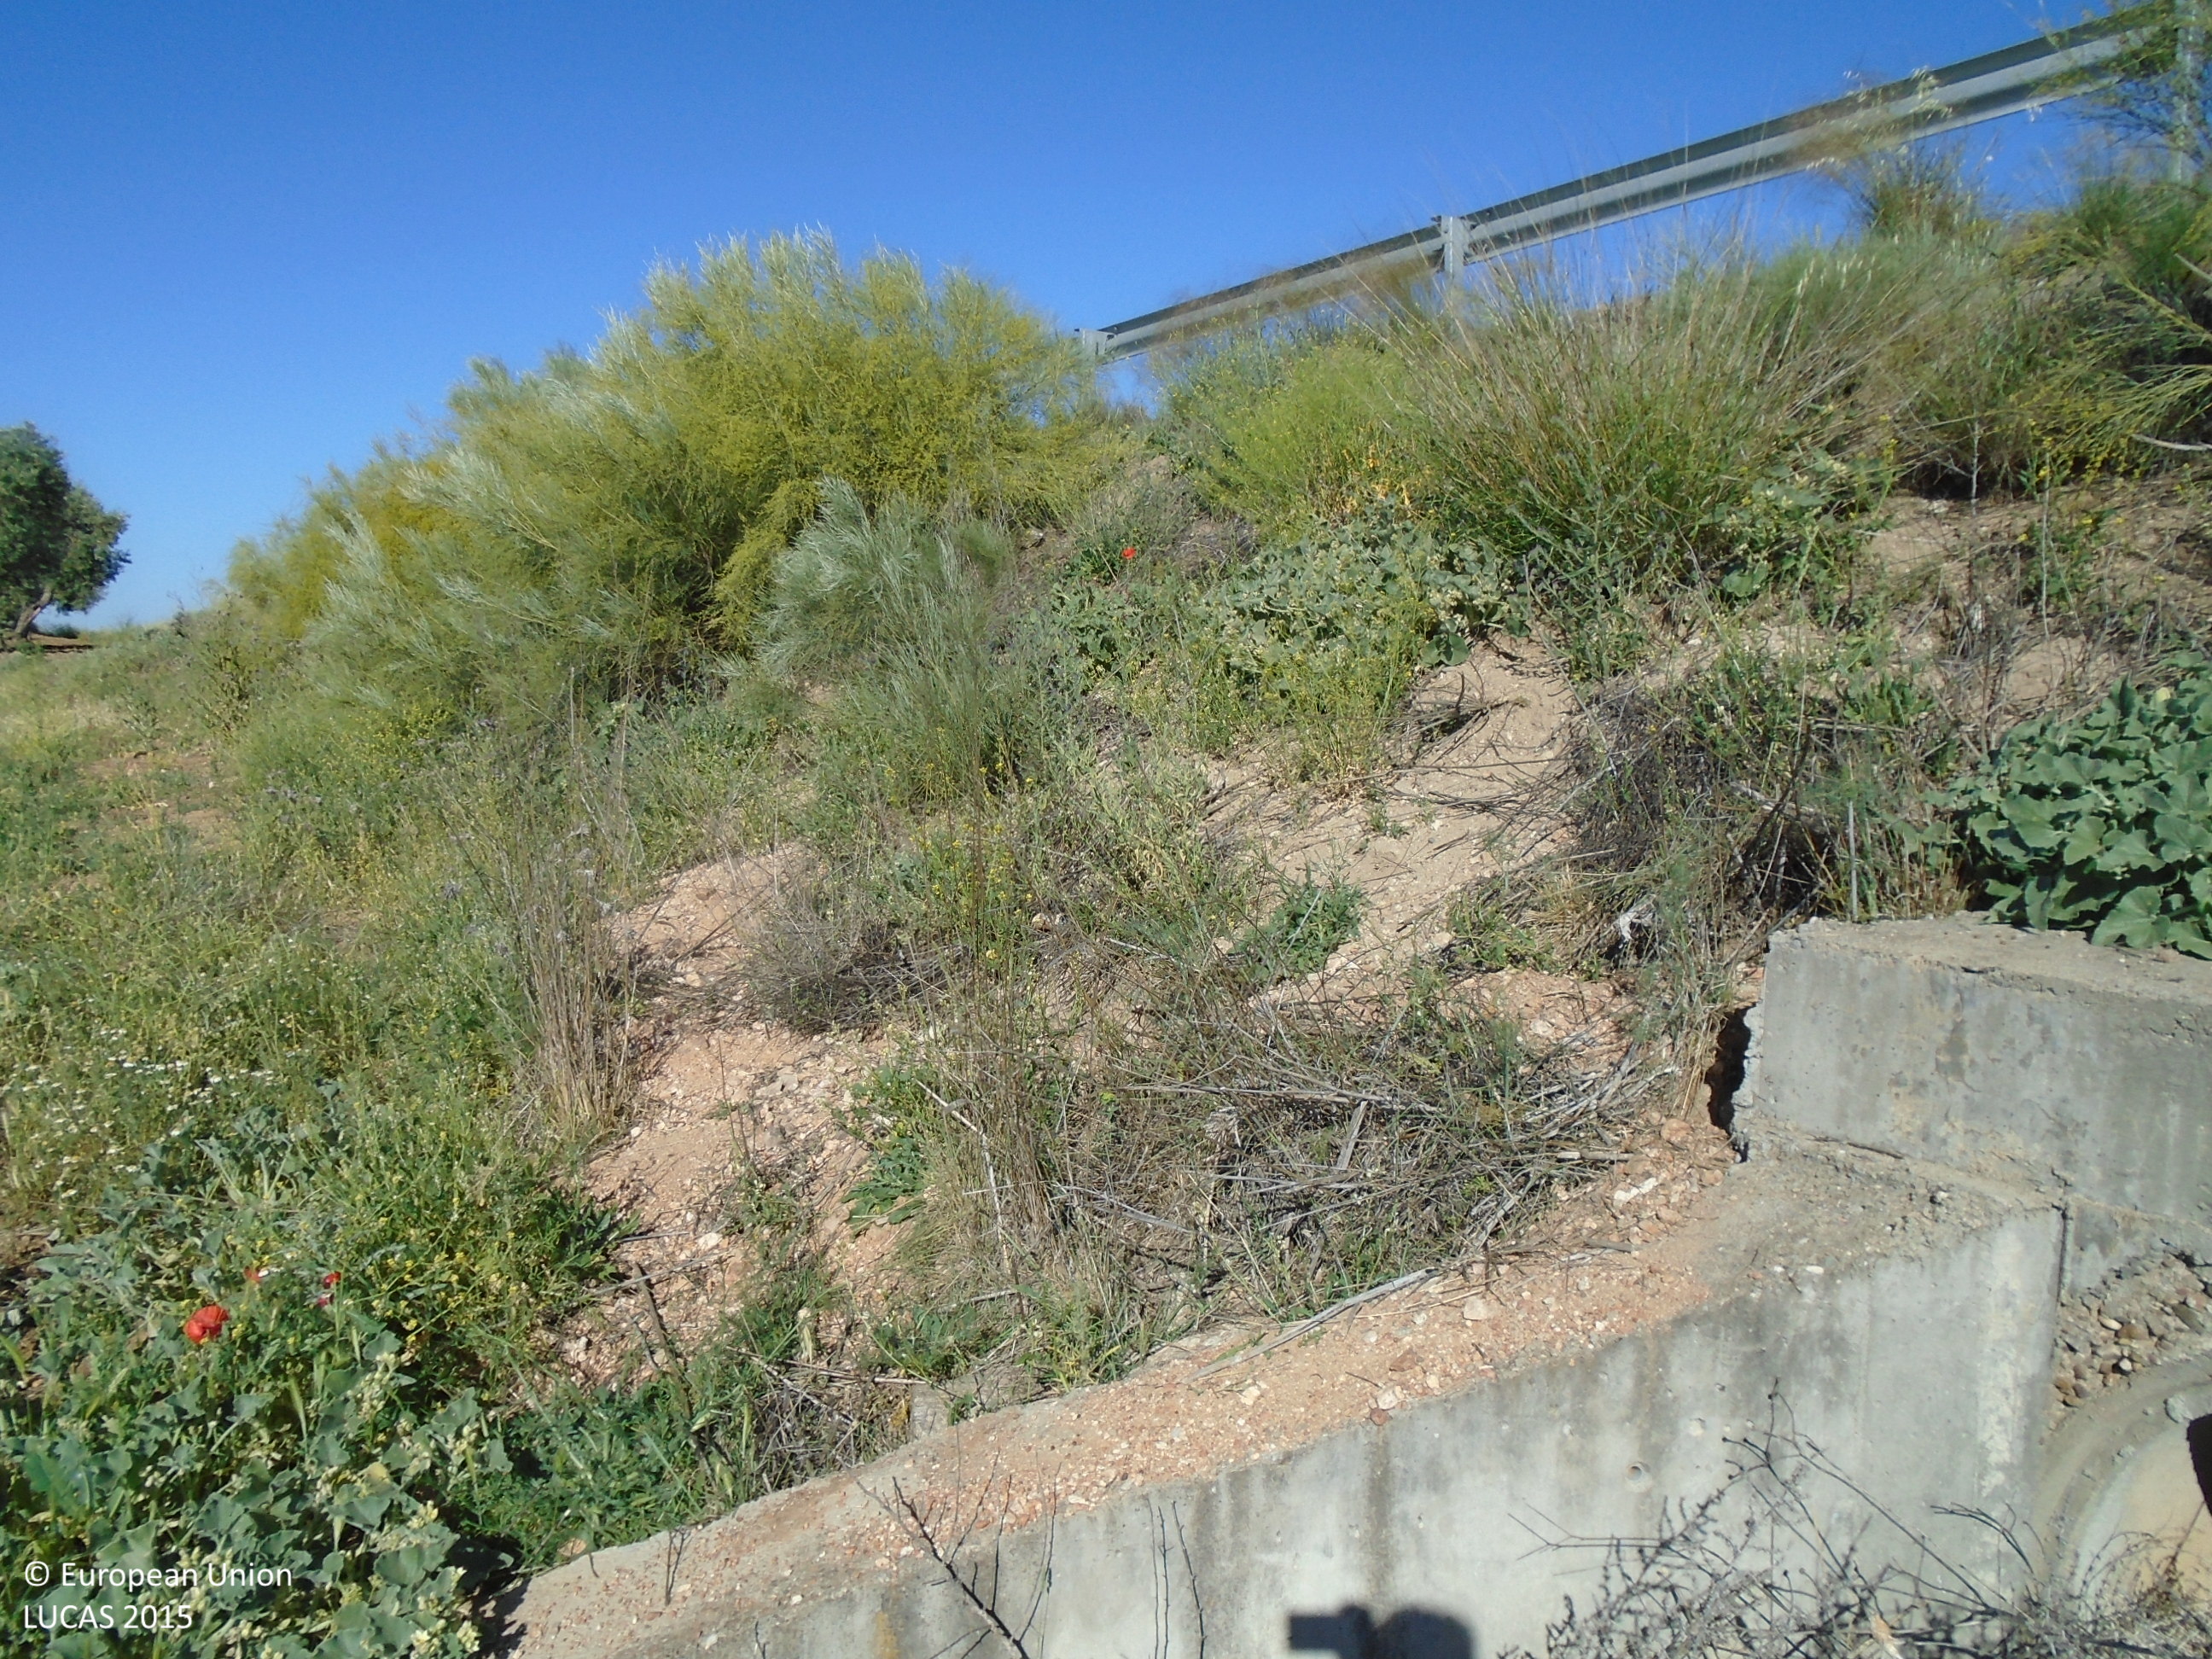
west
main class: Grassland
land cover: Spontaneously vegetated surfaces
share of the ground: > 75 %
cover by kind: herbaceous plants 95 %, consolidated bare surface 5 %
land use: Semi-natural and natural areas not in use
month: May
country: ES
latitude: 39.7177
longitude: -3.7354
